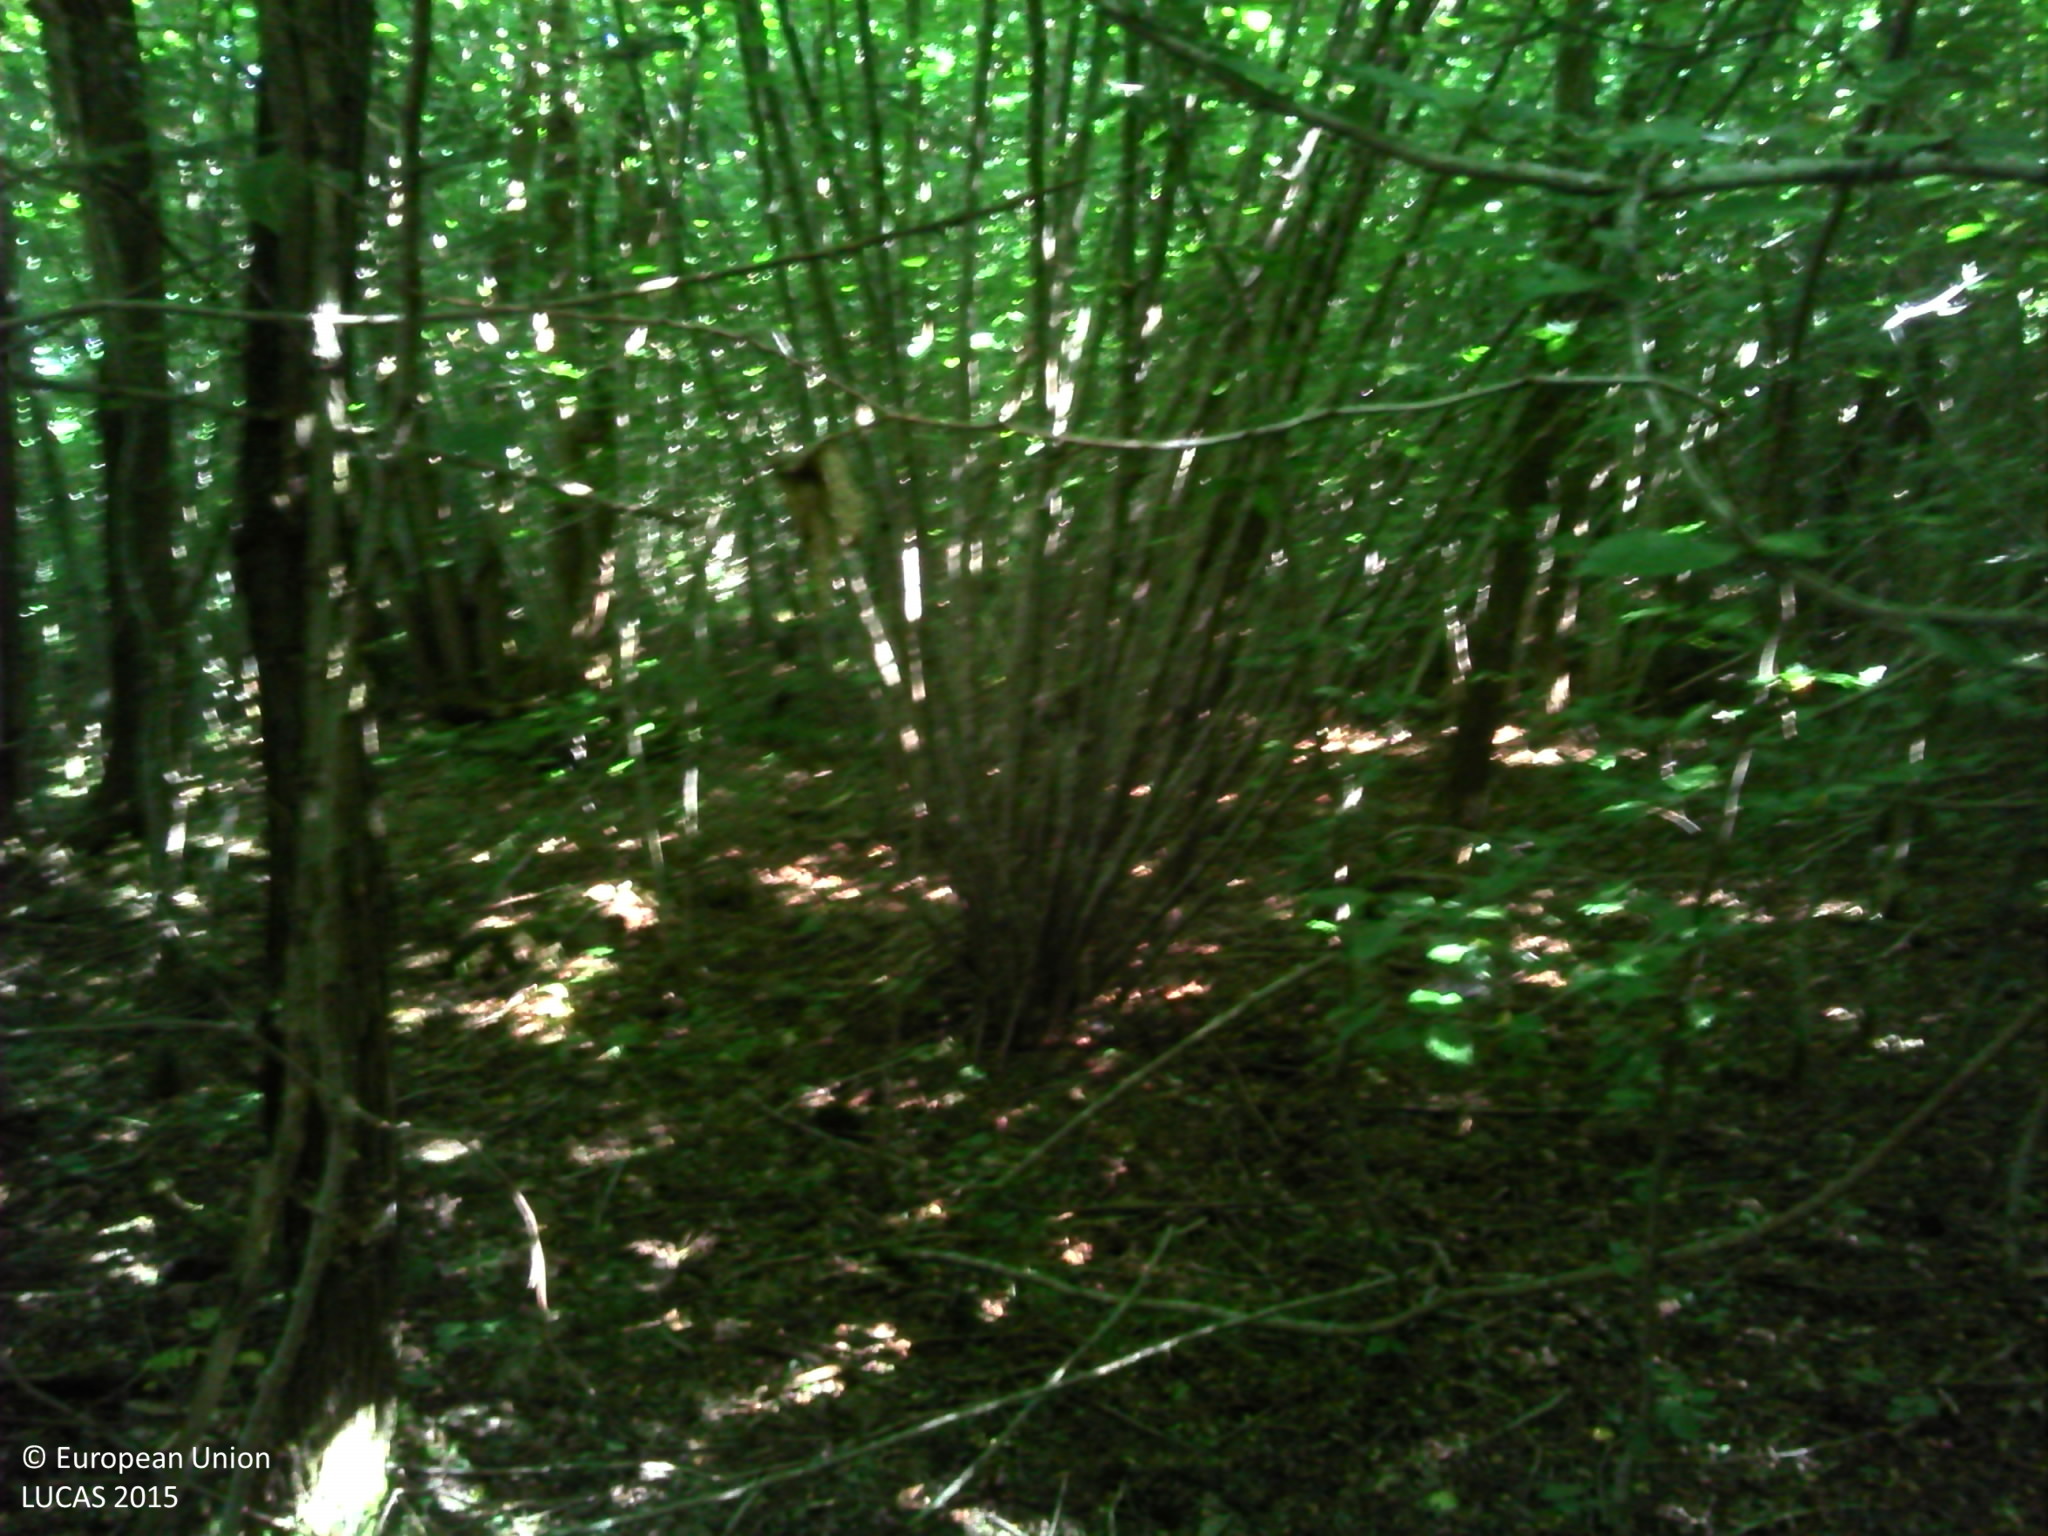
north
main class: Woodland
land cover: Broadleaved woodland
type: mesophytic deciduous forest
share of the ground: > 75 %
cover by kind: broadleaved forest trees 90 %, herbaceous plants 5 %, lichens and mosses 5 %
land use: Forestry
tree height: > 5 m
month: July
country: FR
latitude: 48.4320
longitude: 6.3106
